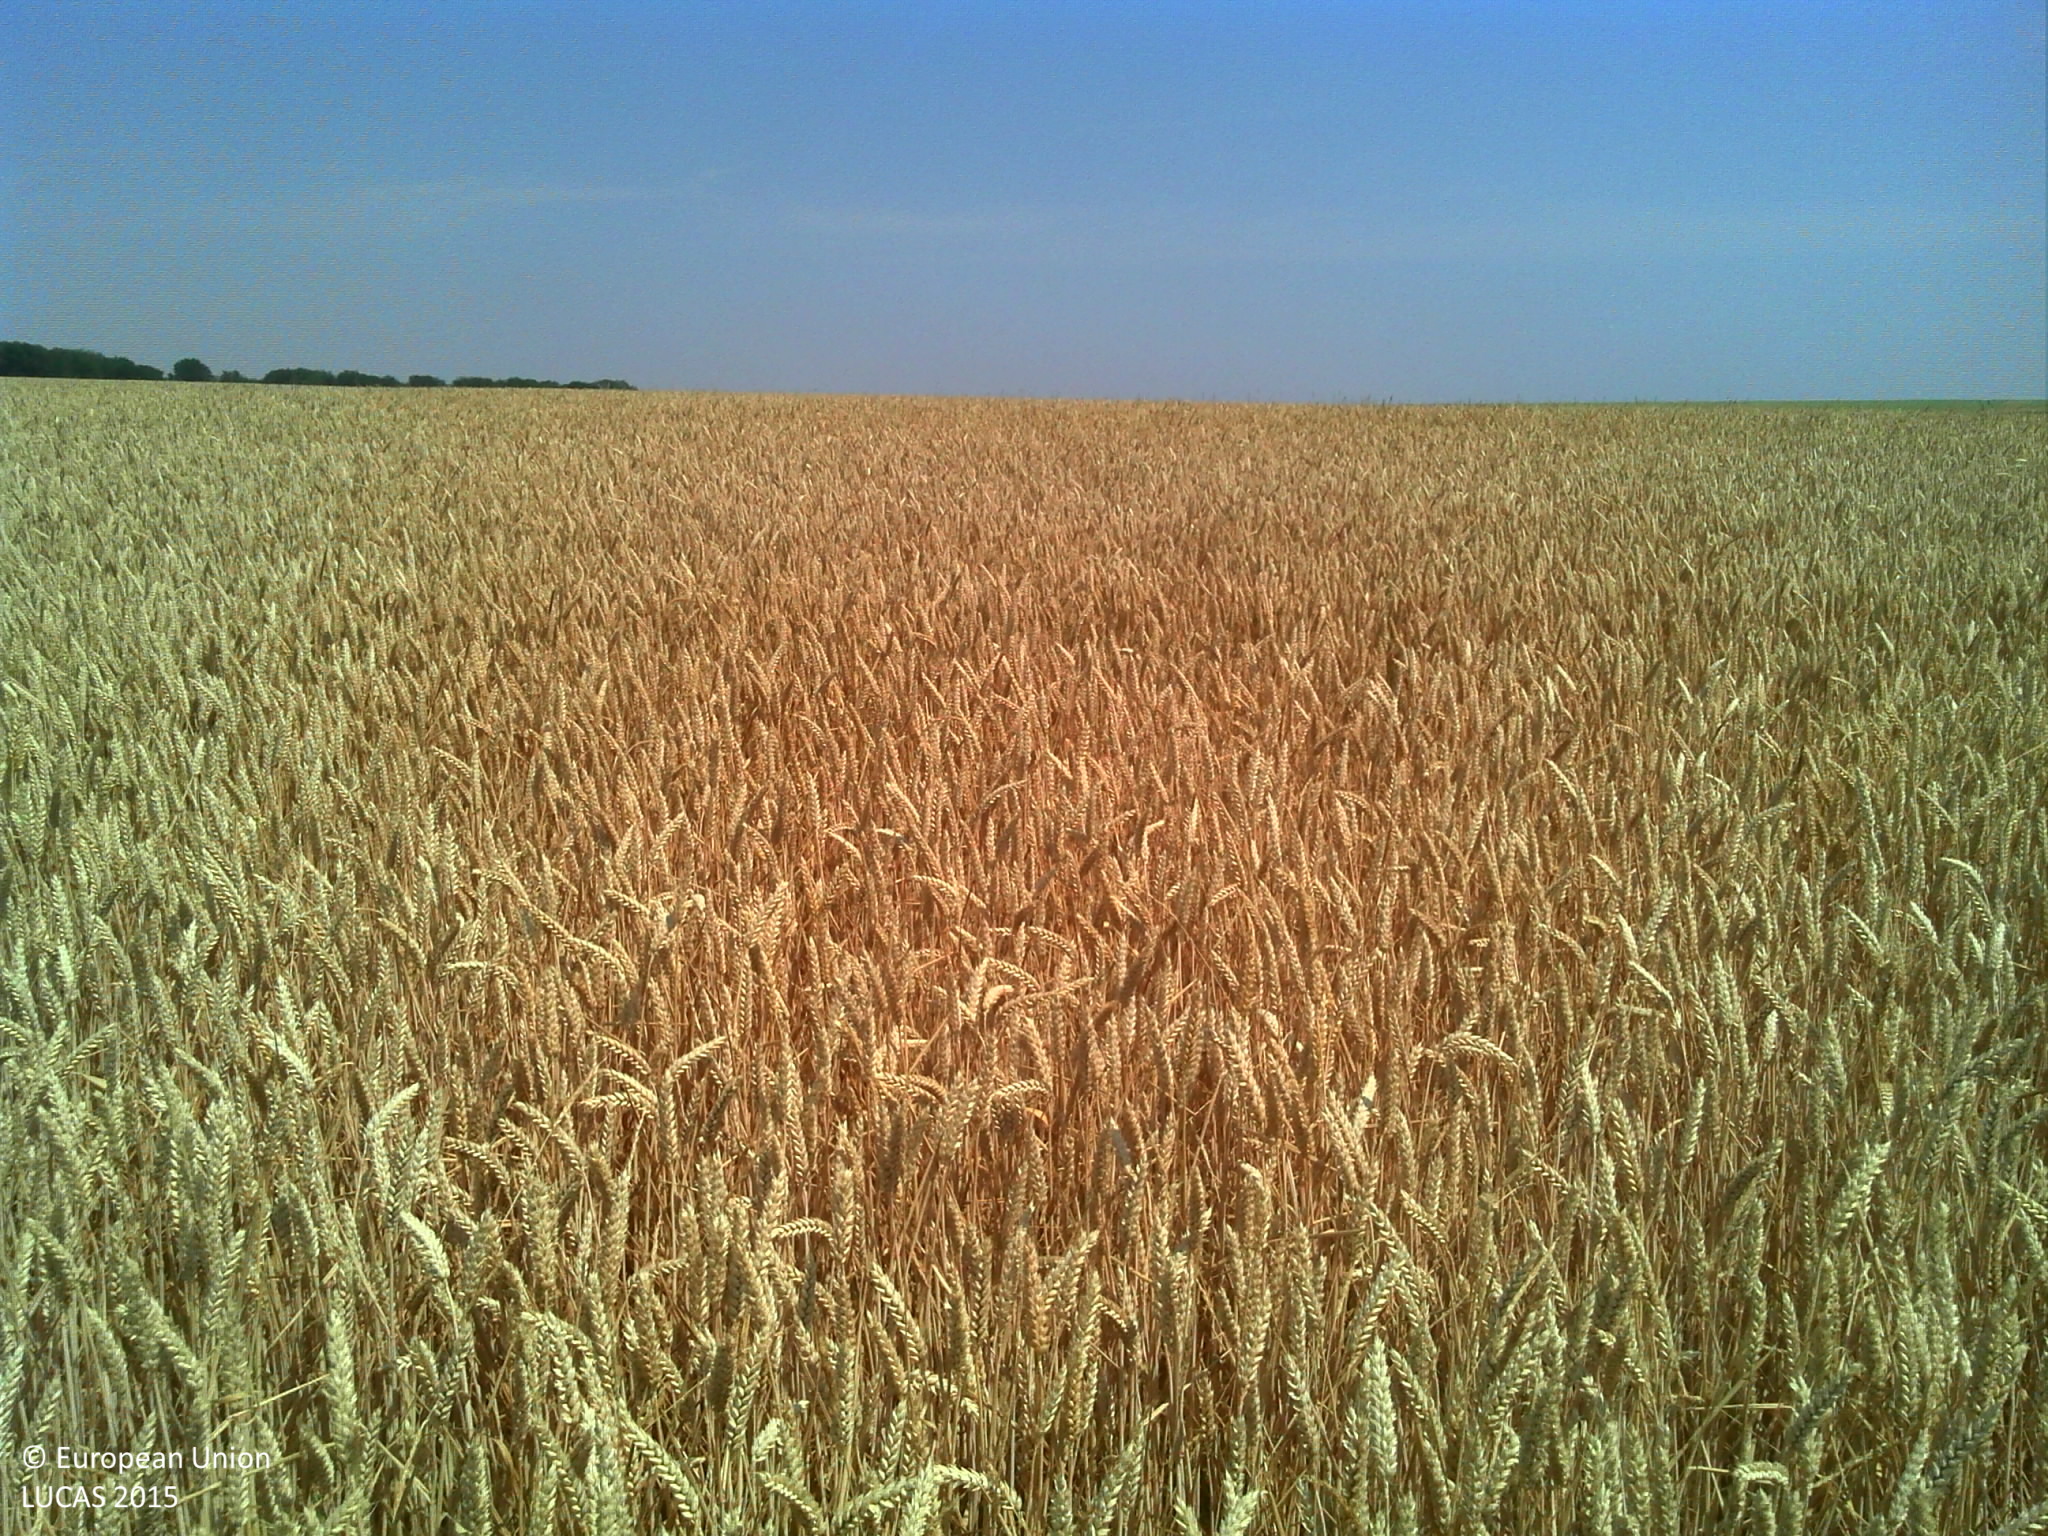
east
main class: Cropland
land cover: Common wheat
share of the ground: > 75 %
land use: Agriculture (excluding fallow land and kitchen gardens)
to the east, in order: Common wheat
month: July
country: FR
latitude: 49.1562
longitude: 3.2871
